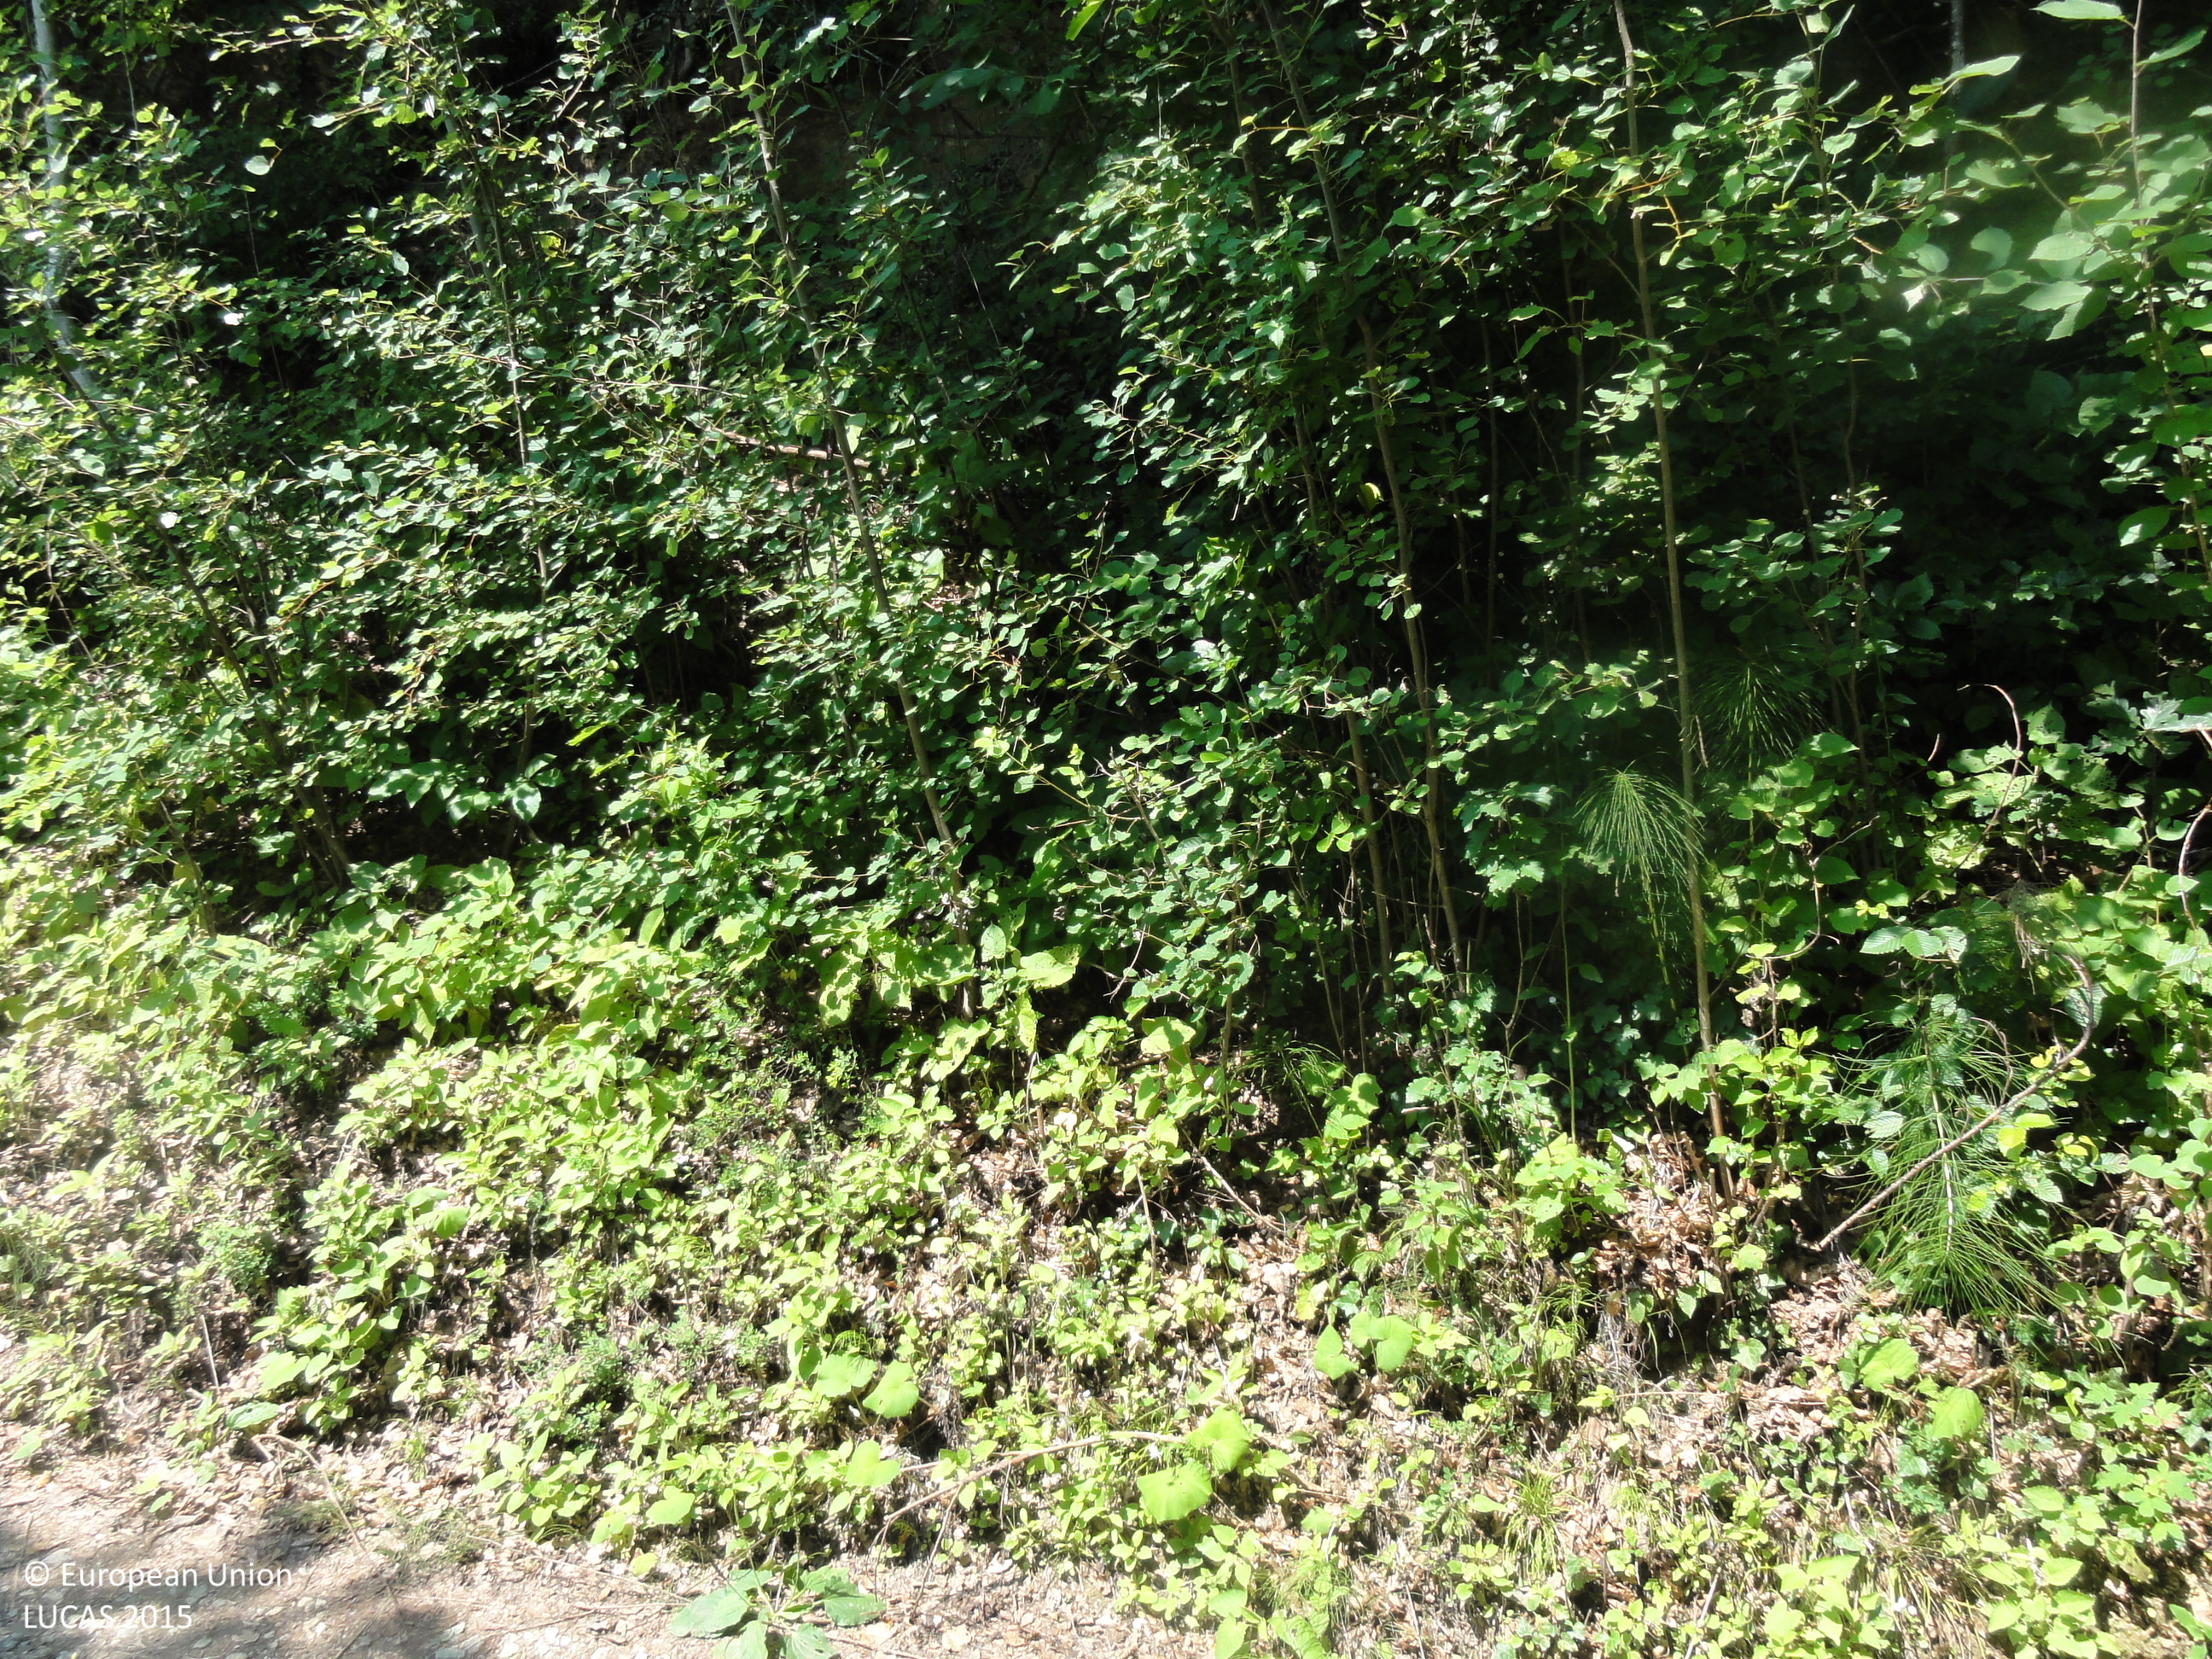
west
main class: Woodland
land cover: Broadleaved woodland
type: beech forest
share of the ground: > 75 %
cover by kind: broadleaved forest trees 85 %, shrubs 10 %, unconsolidated bare surface 5 %
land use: Forestry
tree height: > 5 m
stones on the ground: < 10 %
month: August
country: SI
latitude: 46.1735
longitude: 15.5029
